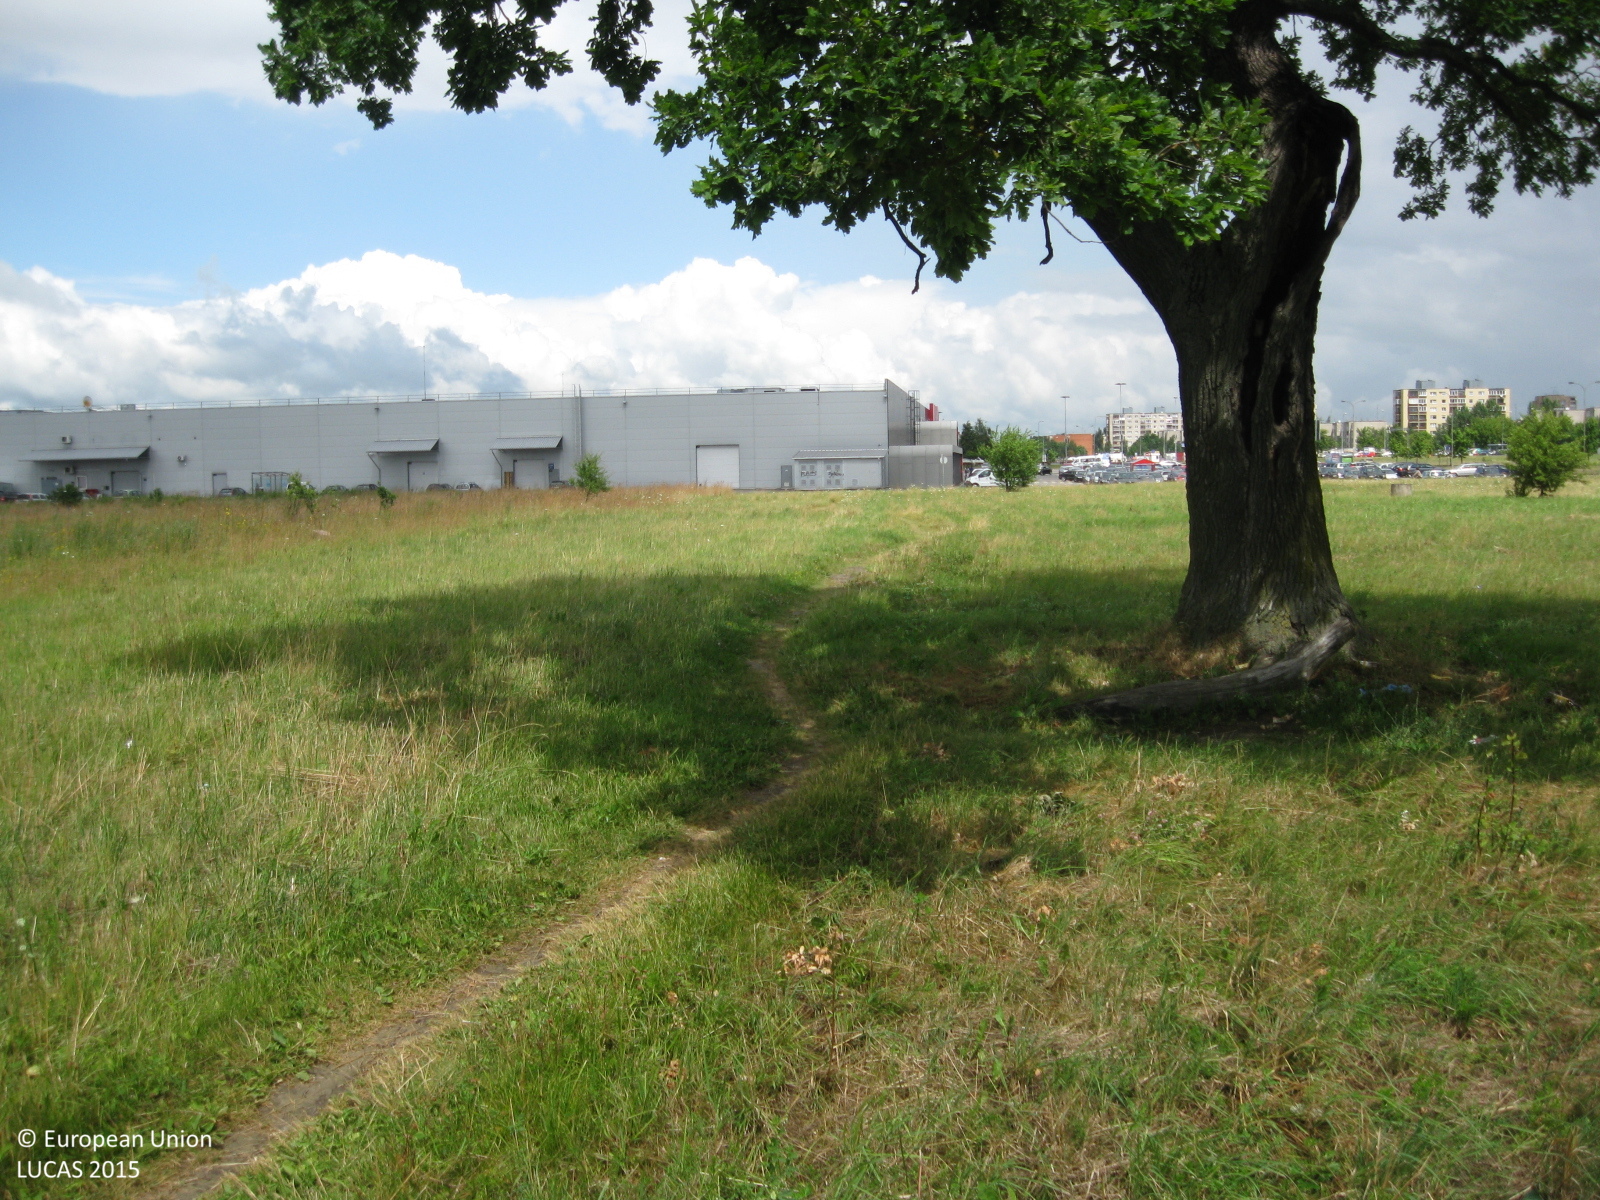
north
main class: Grassland
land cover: Grassland with sparse tree/shrub cover
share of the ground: > 75 %
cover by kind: herbaceous plants 90 %, broadleaved forest trees 5 %, shrubs 5 %
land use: Amenities, museums, leisure
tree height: > 5 m
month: July
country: LT
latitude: 55.7270
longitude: 24.3139
